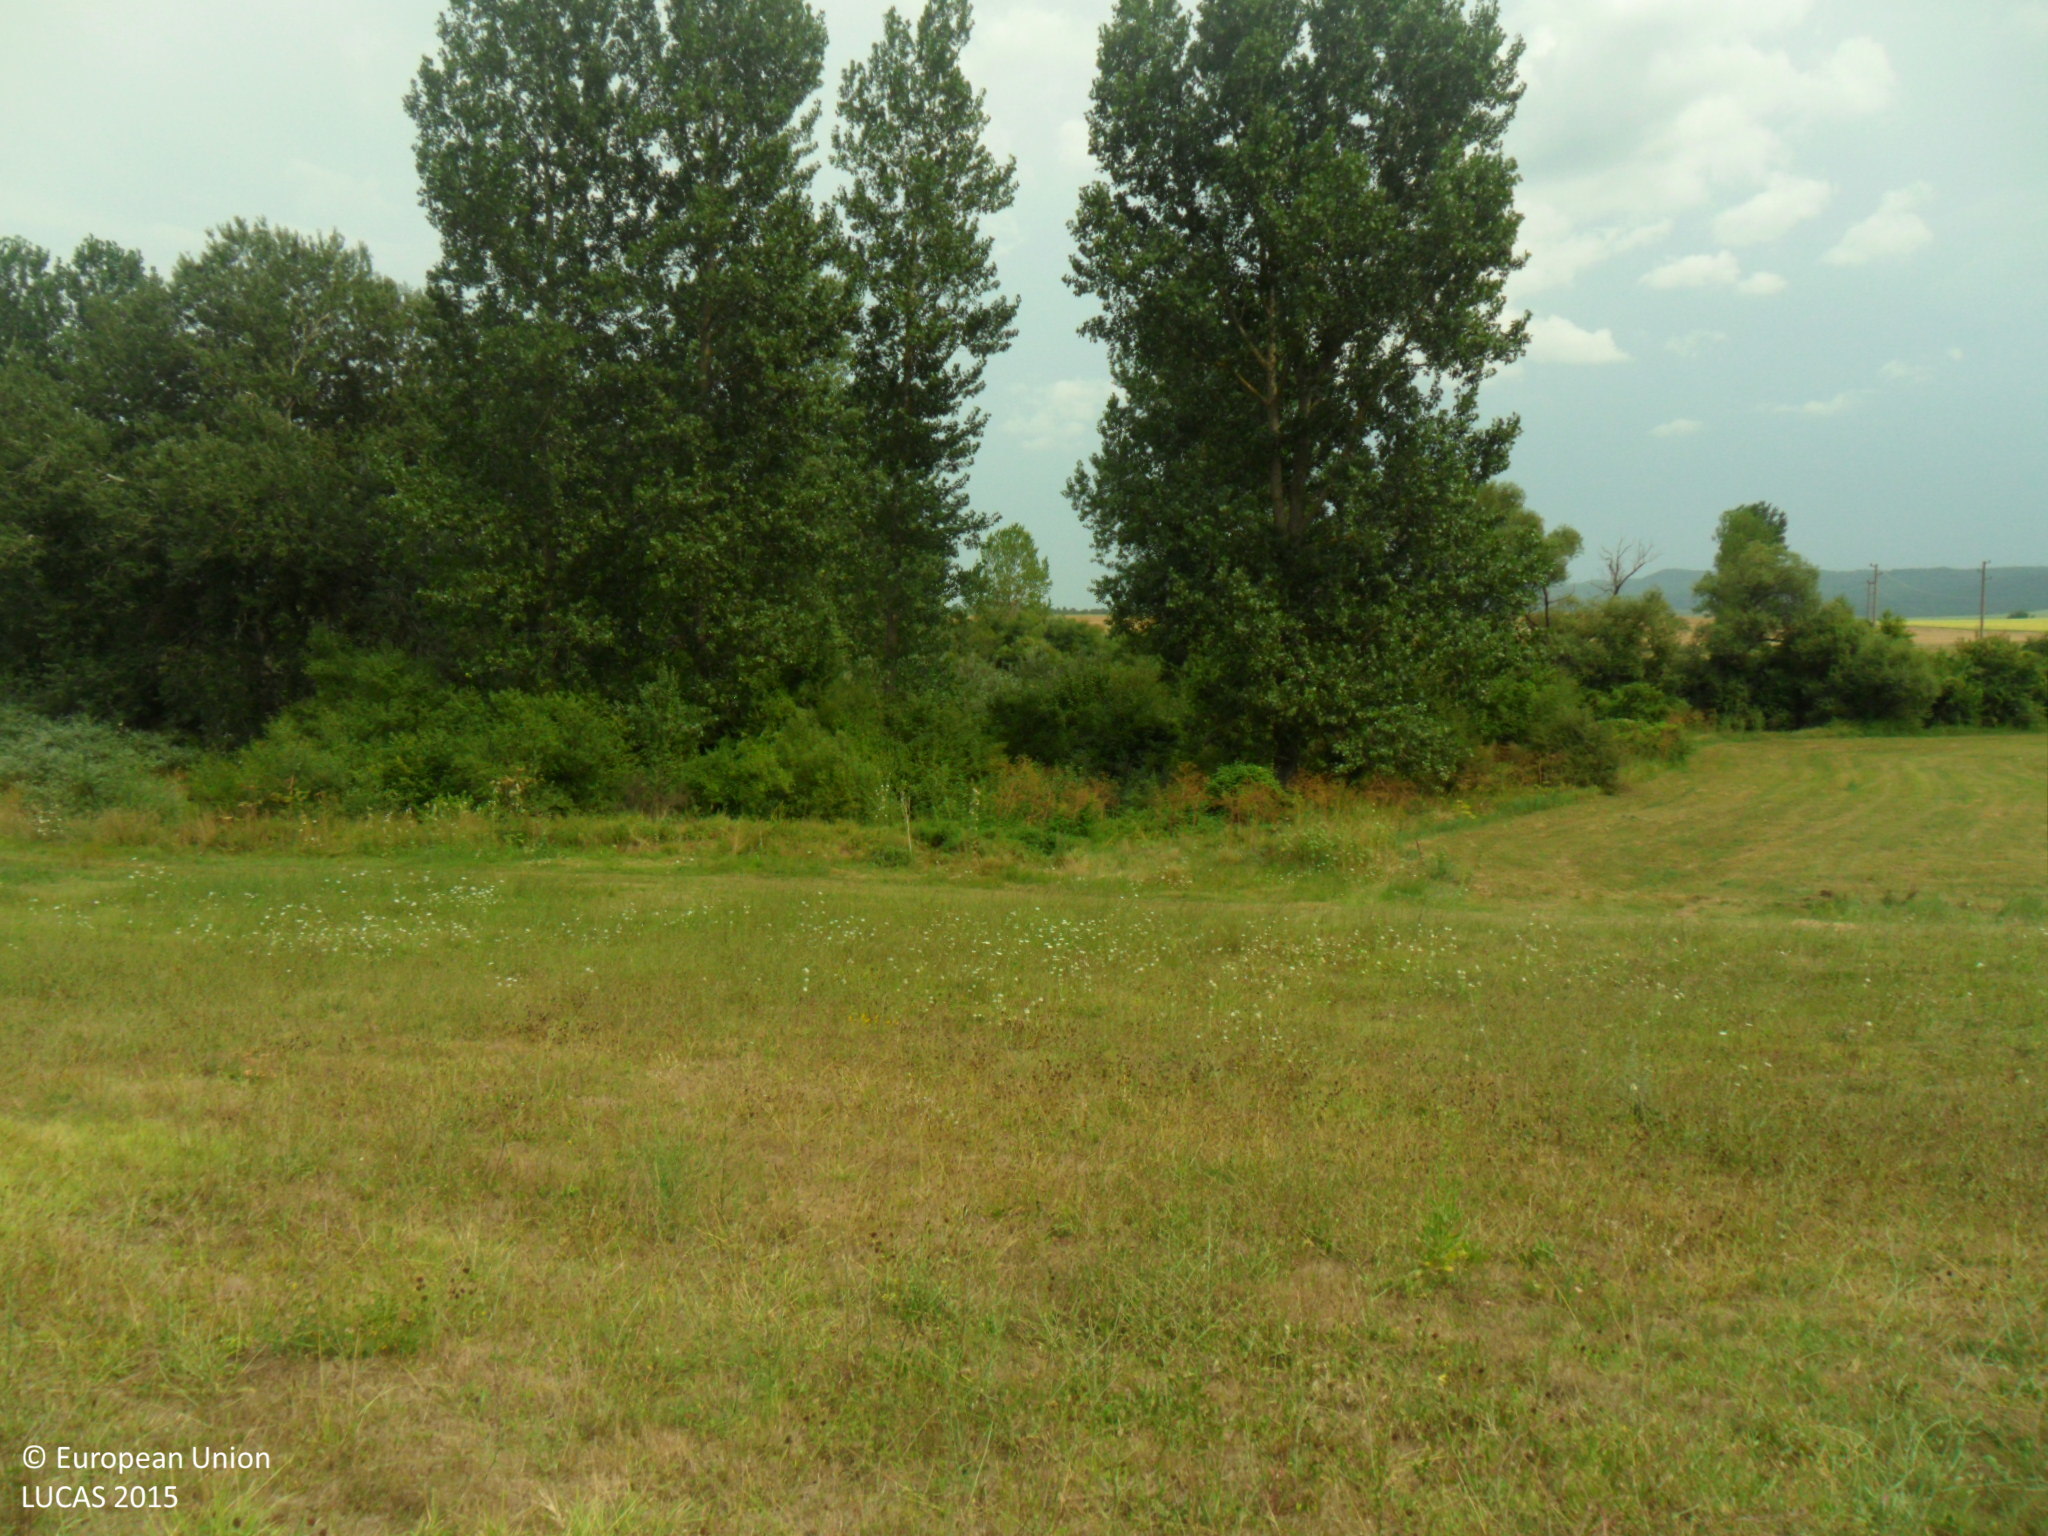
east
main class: Grassland
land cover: Spontaneously vegetated surfaces
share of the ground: > 75 %
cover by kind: herbaceous plants 100 %
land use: Fallow land
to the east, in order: Spontaneously vegetated surfaces; Tracks; Grass margins; Broadleaved woodland; Grassland without tree/shrub cover; Broadleaved woodland; Rivers and streams; Broadleaved woodland; Grassland without tree/shrub cover; Broadleaved woodland
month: August
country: BG
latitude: 43.0117
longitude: 26.6535
